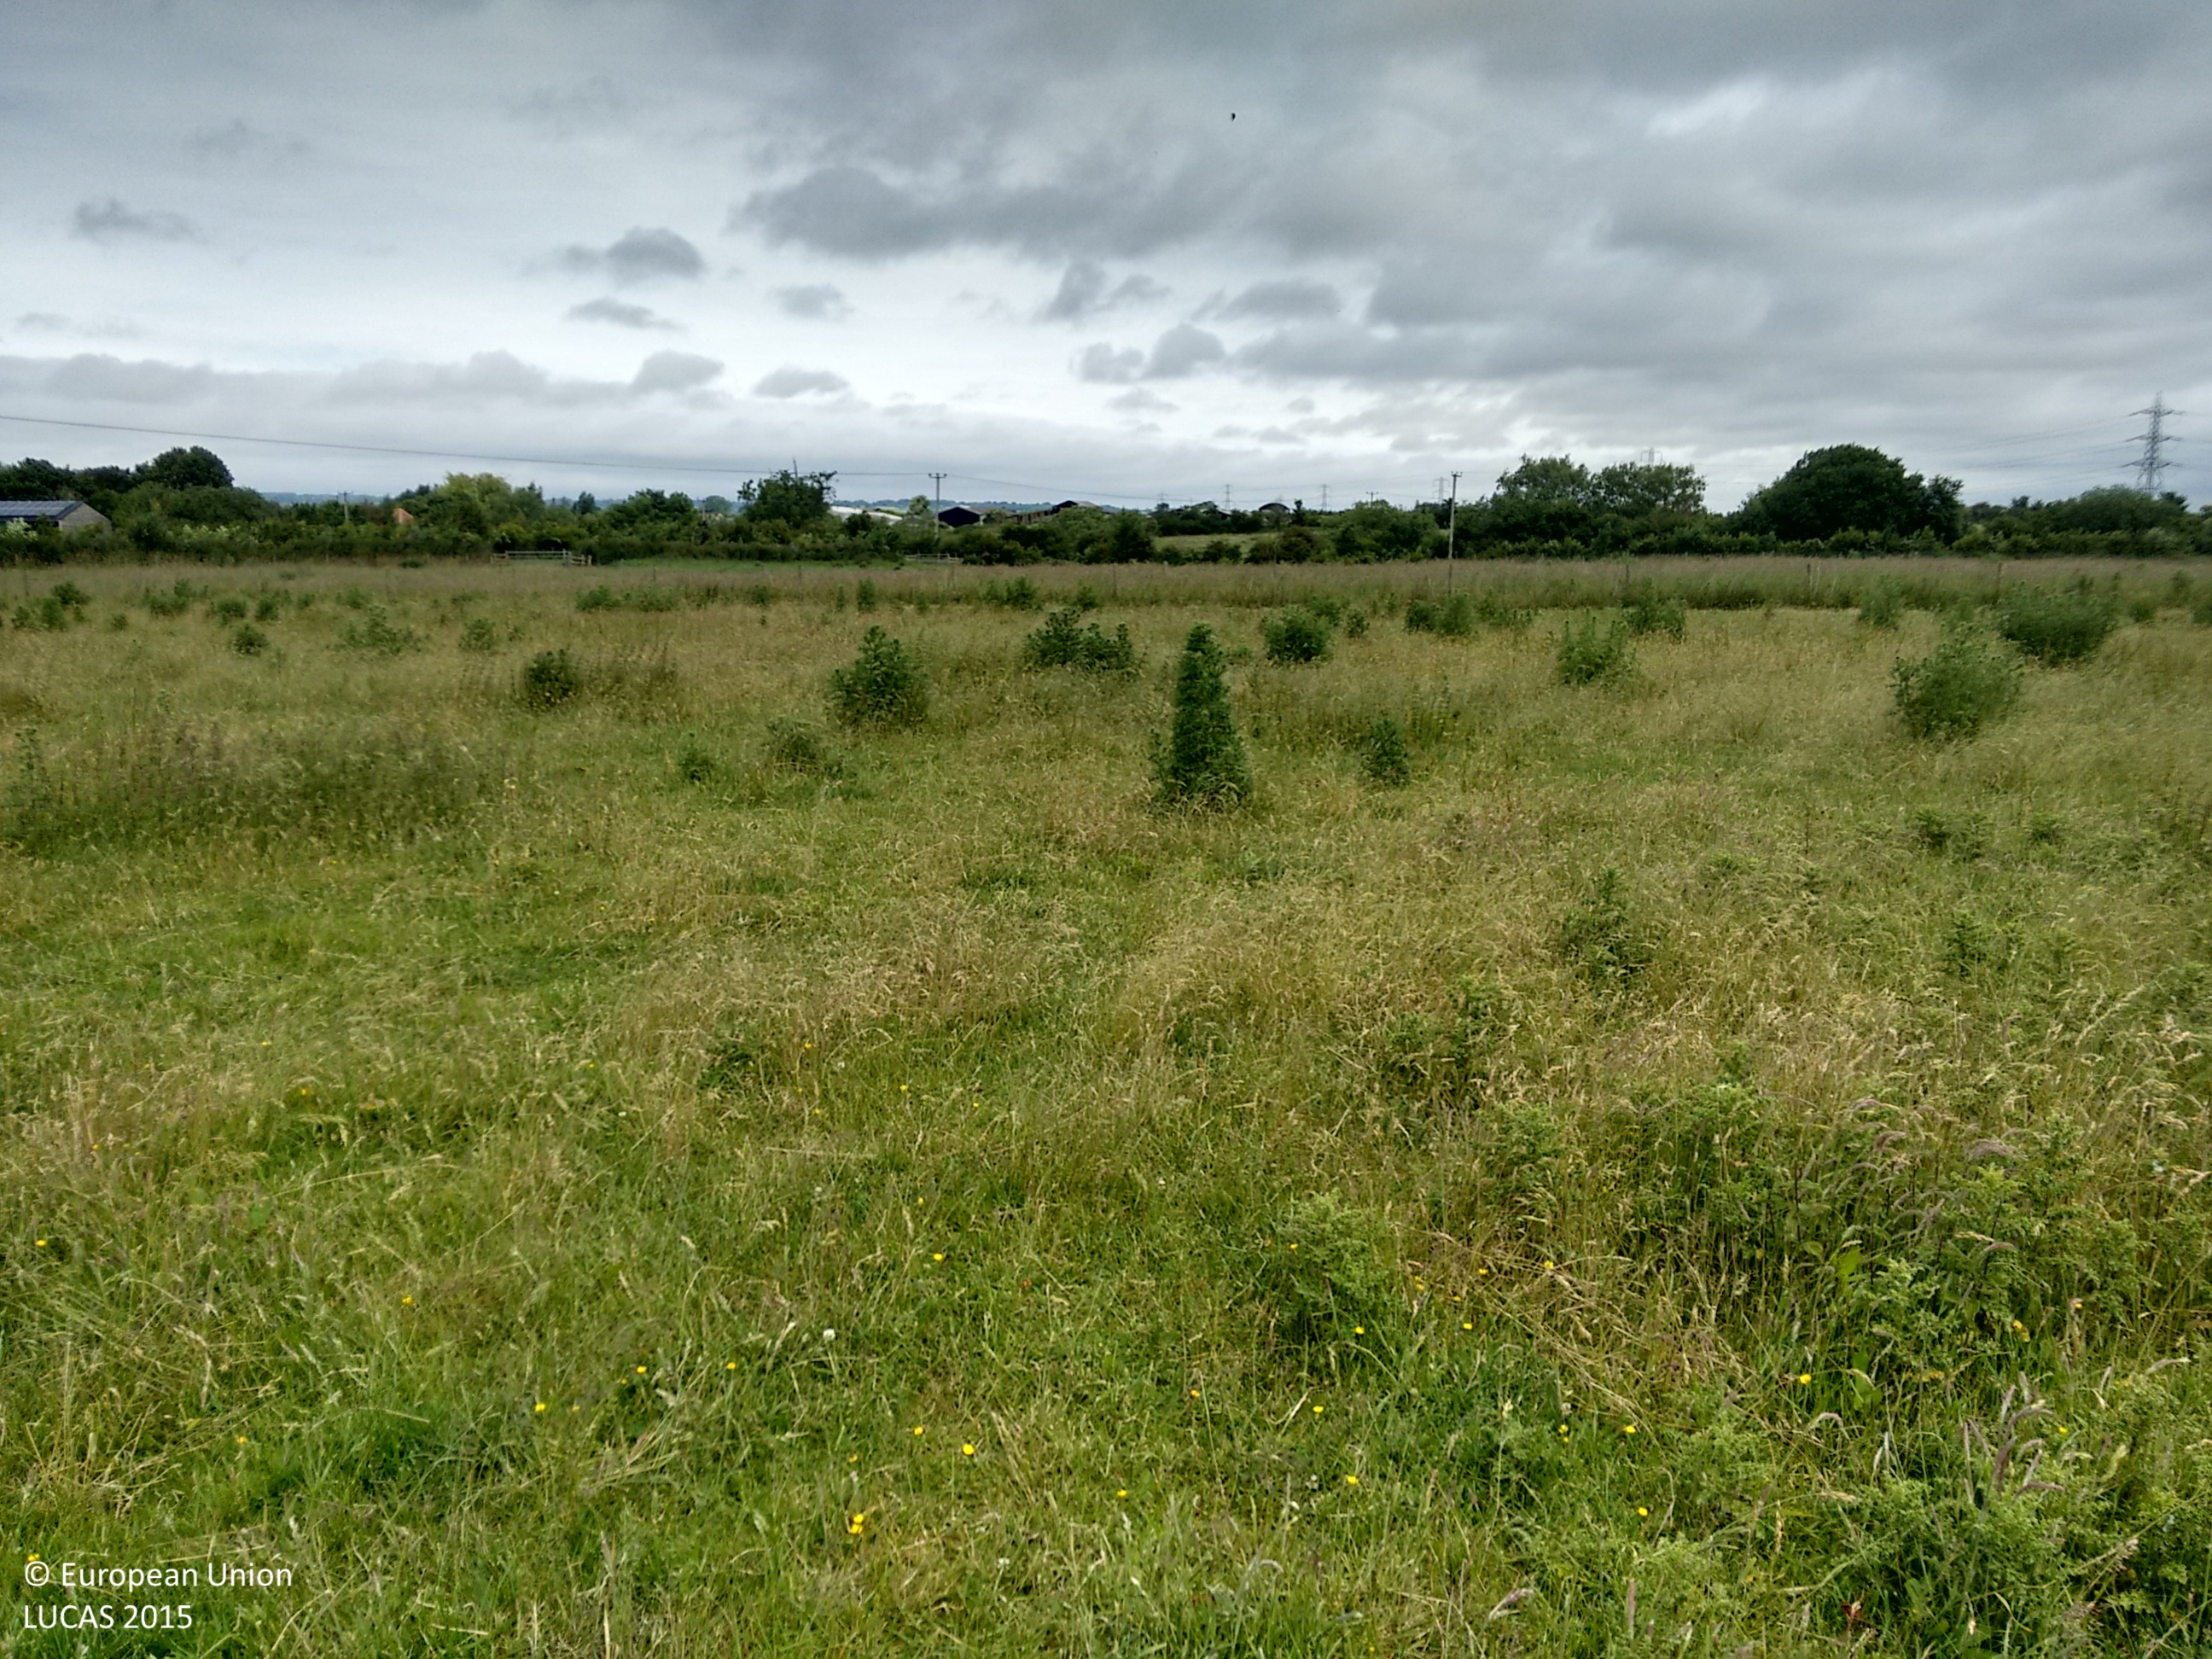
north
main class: Grassland
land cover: Grassland without tree/shrub cover
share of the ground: > 75 %
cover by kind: herbaceous plants 100 %
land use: Agriculture (excluding fallow land and kitchen gardens)
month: June
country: GB
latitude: 51.3488
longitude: -2.1648
